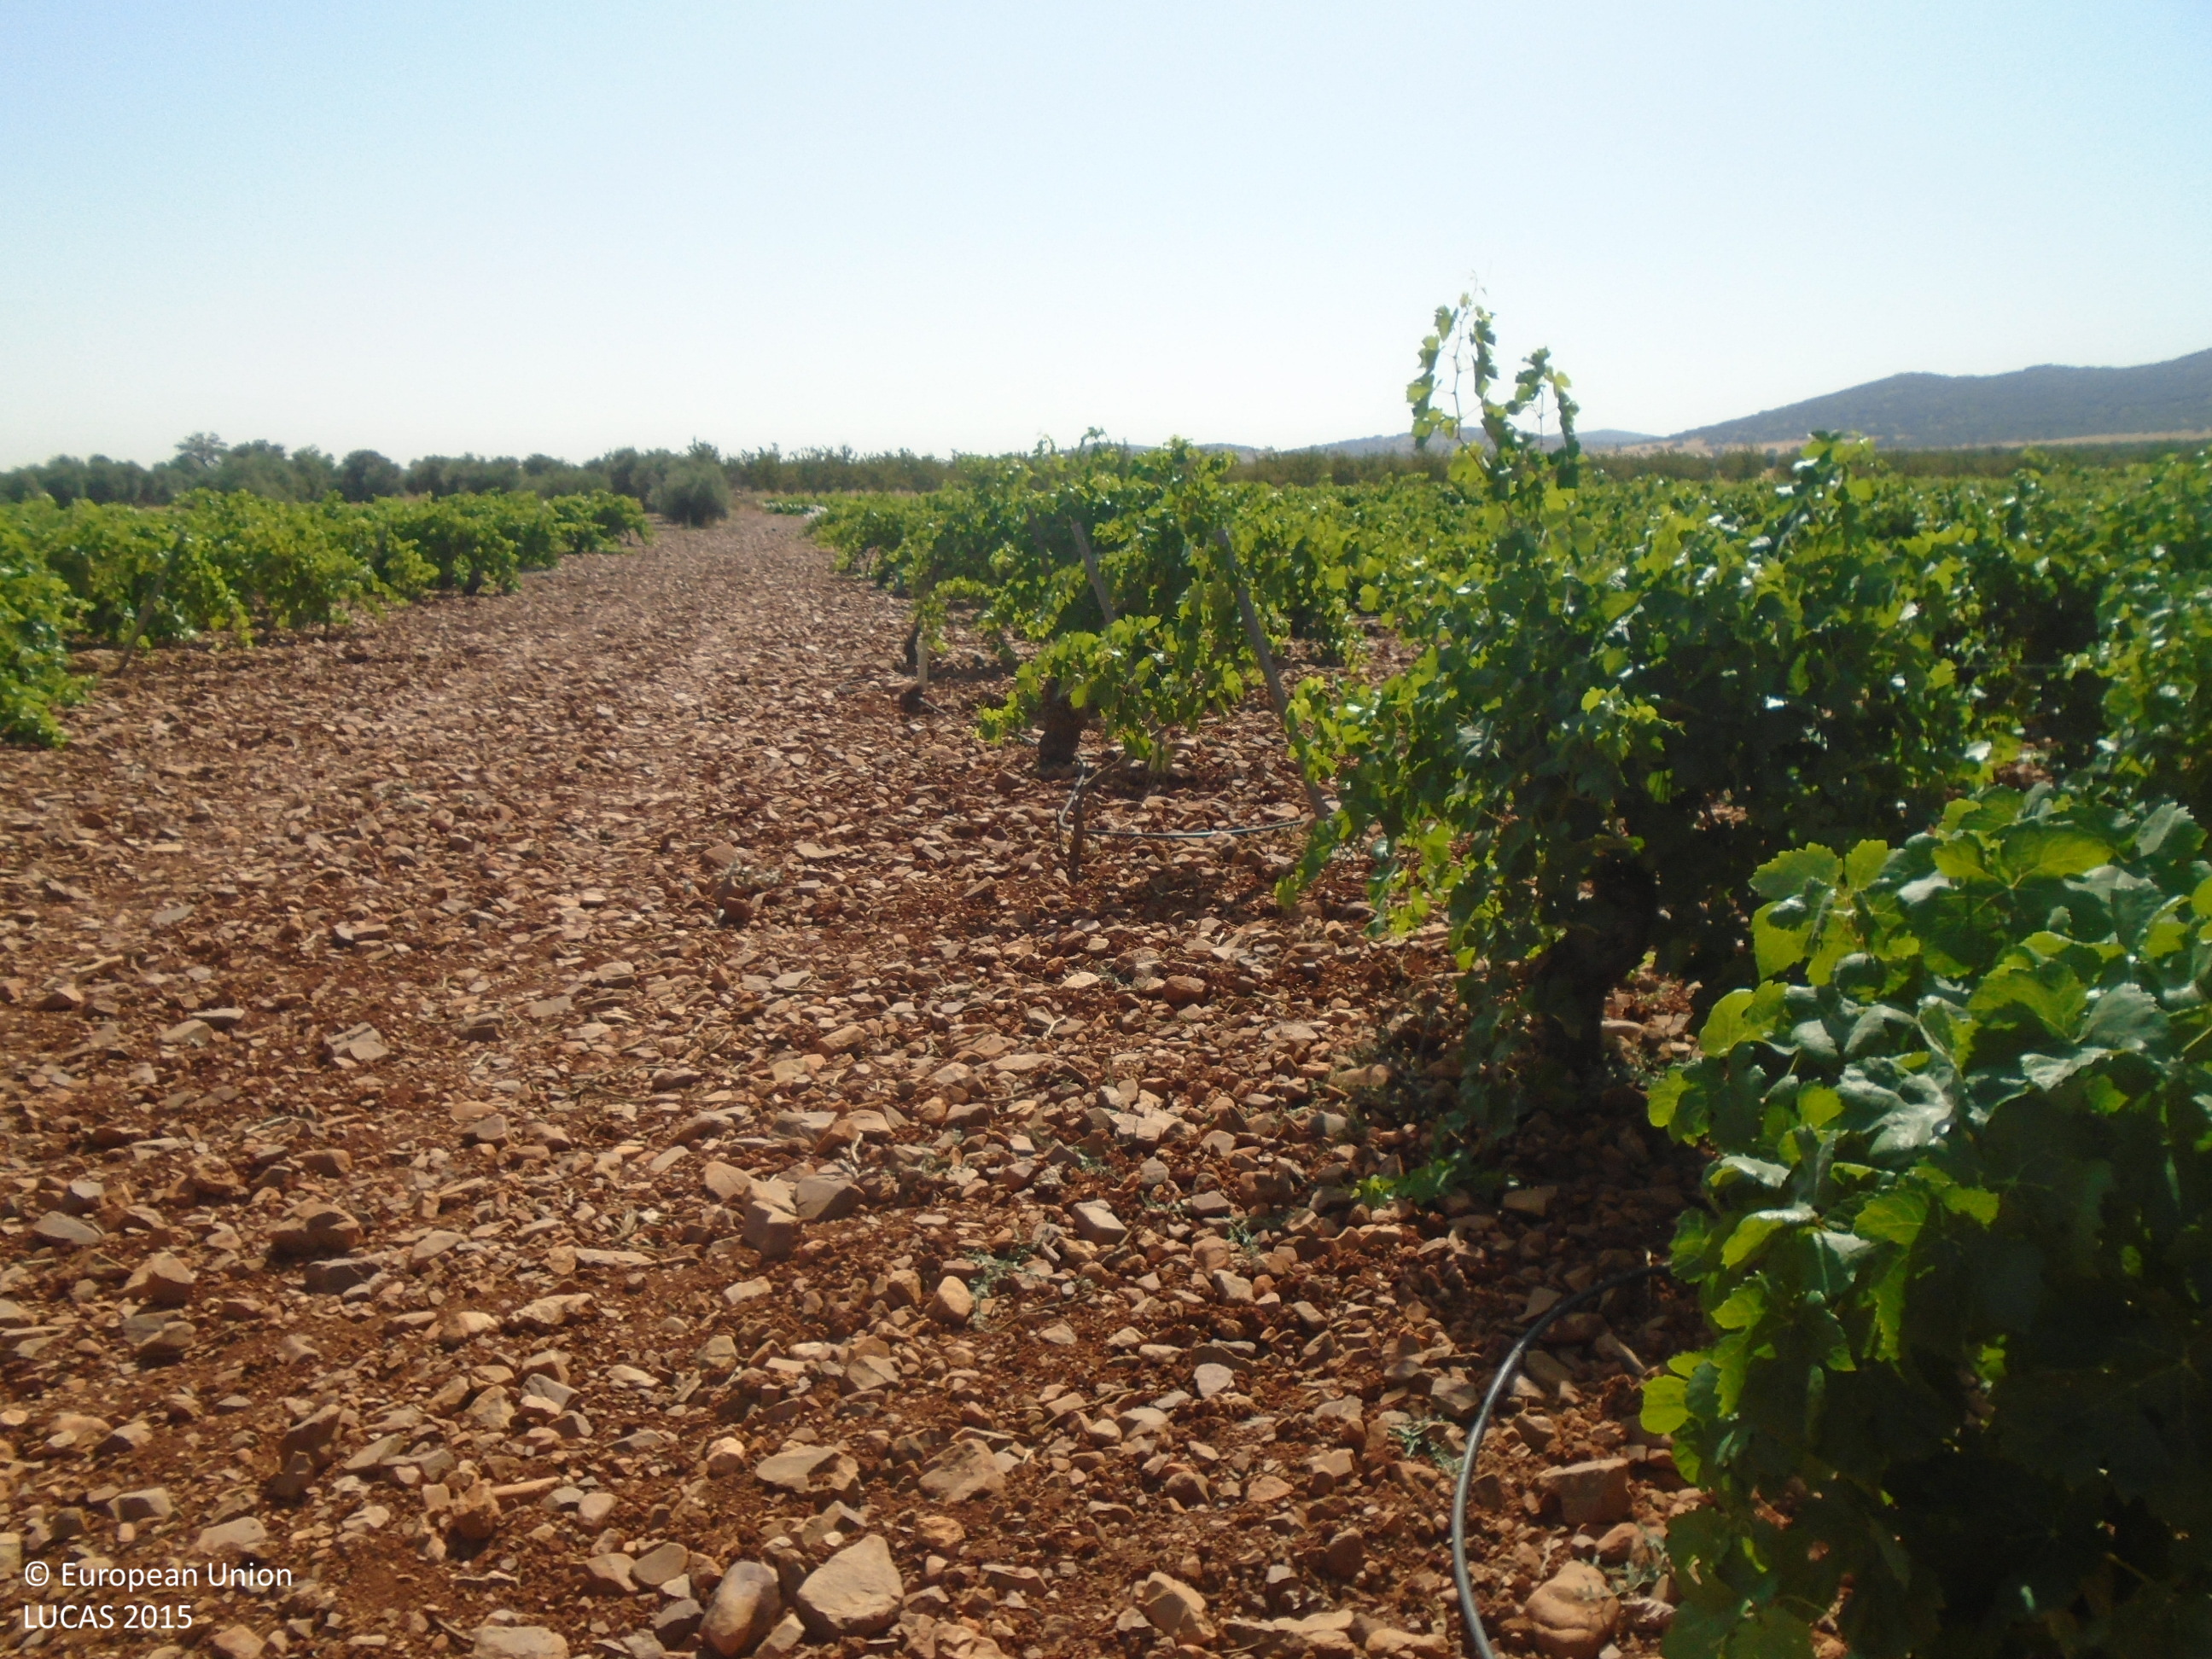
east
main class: Cropland
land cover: Vineyards
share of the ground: 25 - 50 %
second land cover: Other bare soil
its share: > 75 %
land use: Agriculture (excluding fallow land and kitchen gardens)
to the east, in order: Vineyards; Other bare soil; Grass margins; Vineyards; Grass margins; Nuts trees
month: July
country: ES
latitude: 39.3975
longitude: -3.6673
